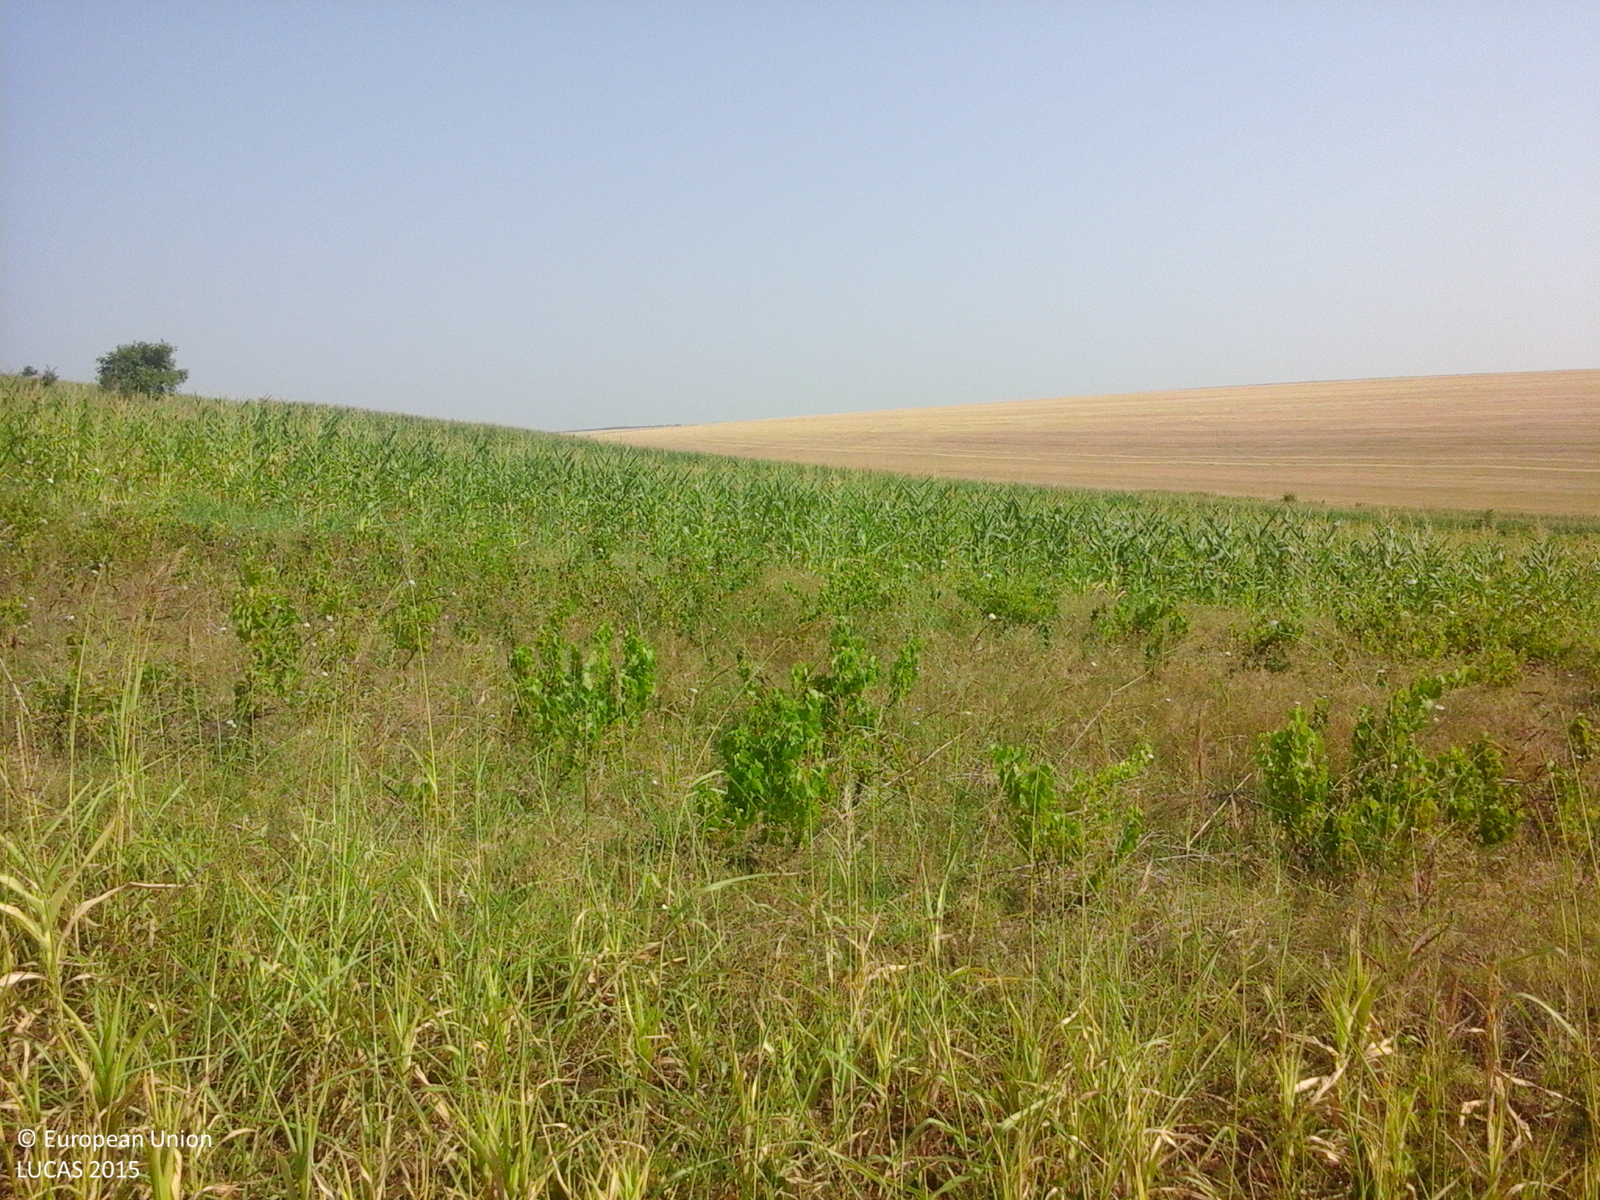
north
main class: Cropland
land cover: Maize
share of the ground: 50 - 75 %
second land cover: Spontaneously vegetated surfaces
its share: 25 - 50 %
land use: Agriculture (excluding fallow land and kitchen gardens)
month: July
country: RO
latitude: 45.7479
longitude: 27.8939
